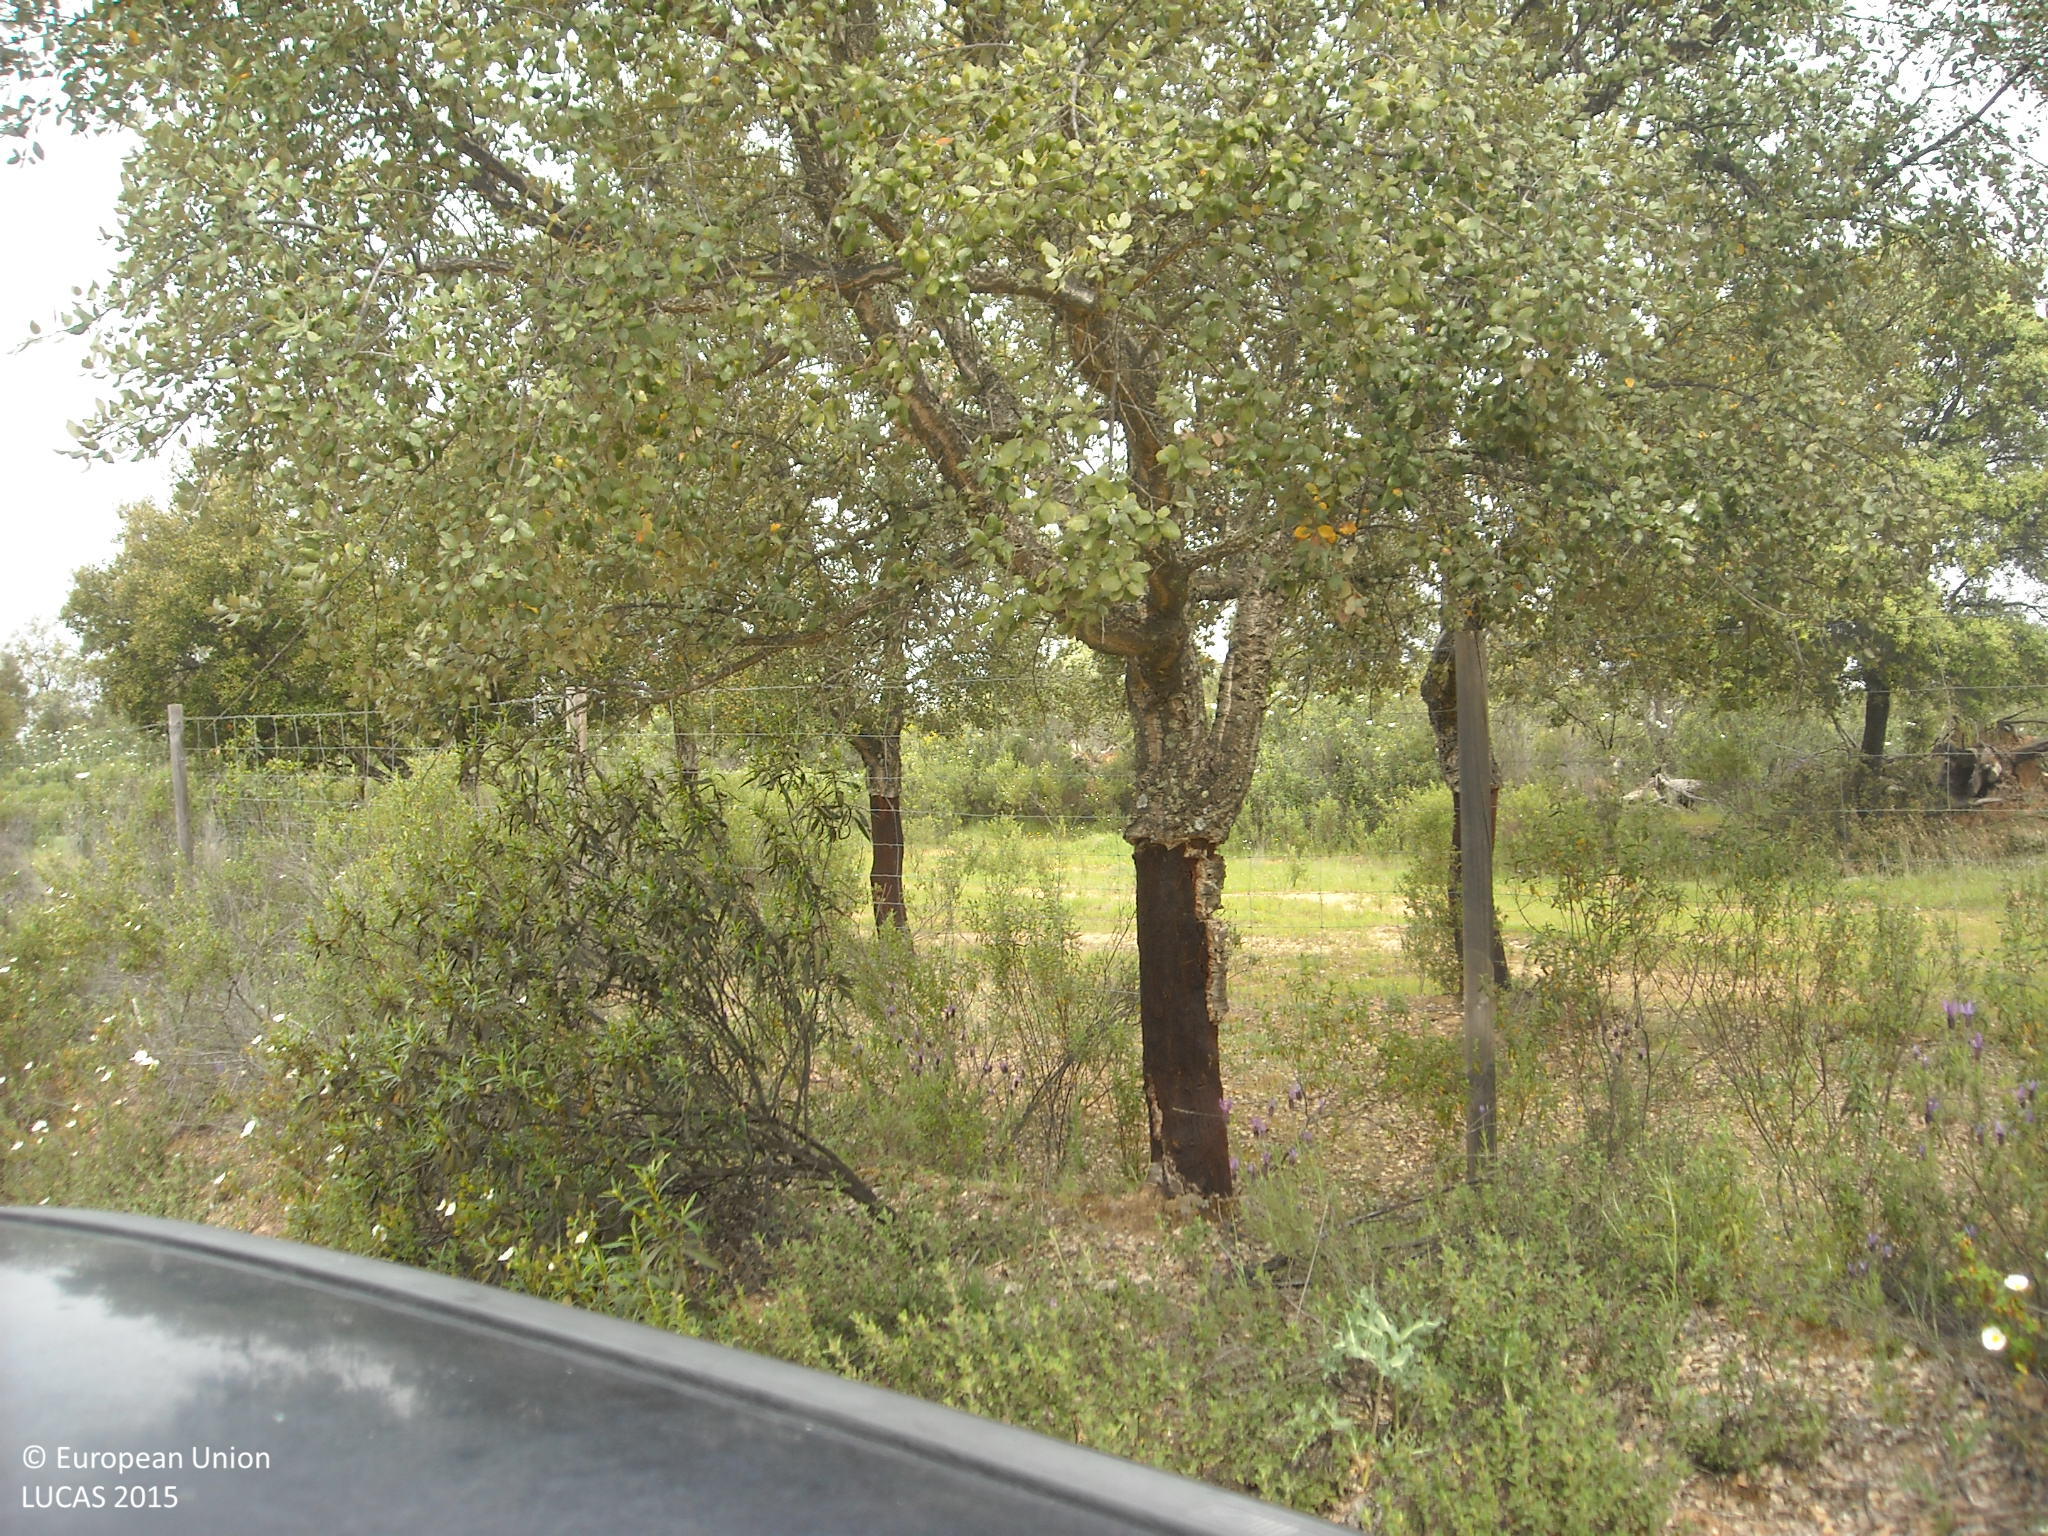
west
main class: Shrubland
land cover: Shrubland with sparse tree cover
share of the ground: 10 - 25 %
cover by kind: herbaceous plants 80 %, shrubs 15 %, broadleaved forest trees 5 %
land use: Forestry
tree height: > 5 m
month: April
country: ES
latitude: 37.8236
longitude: -6.2018
